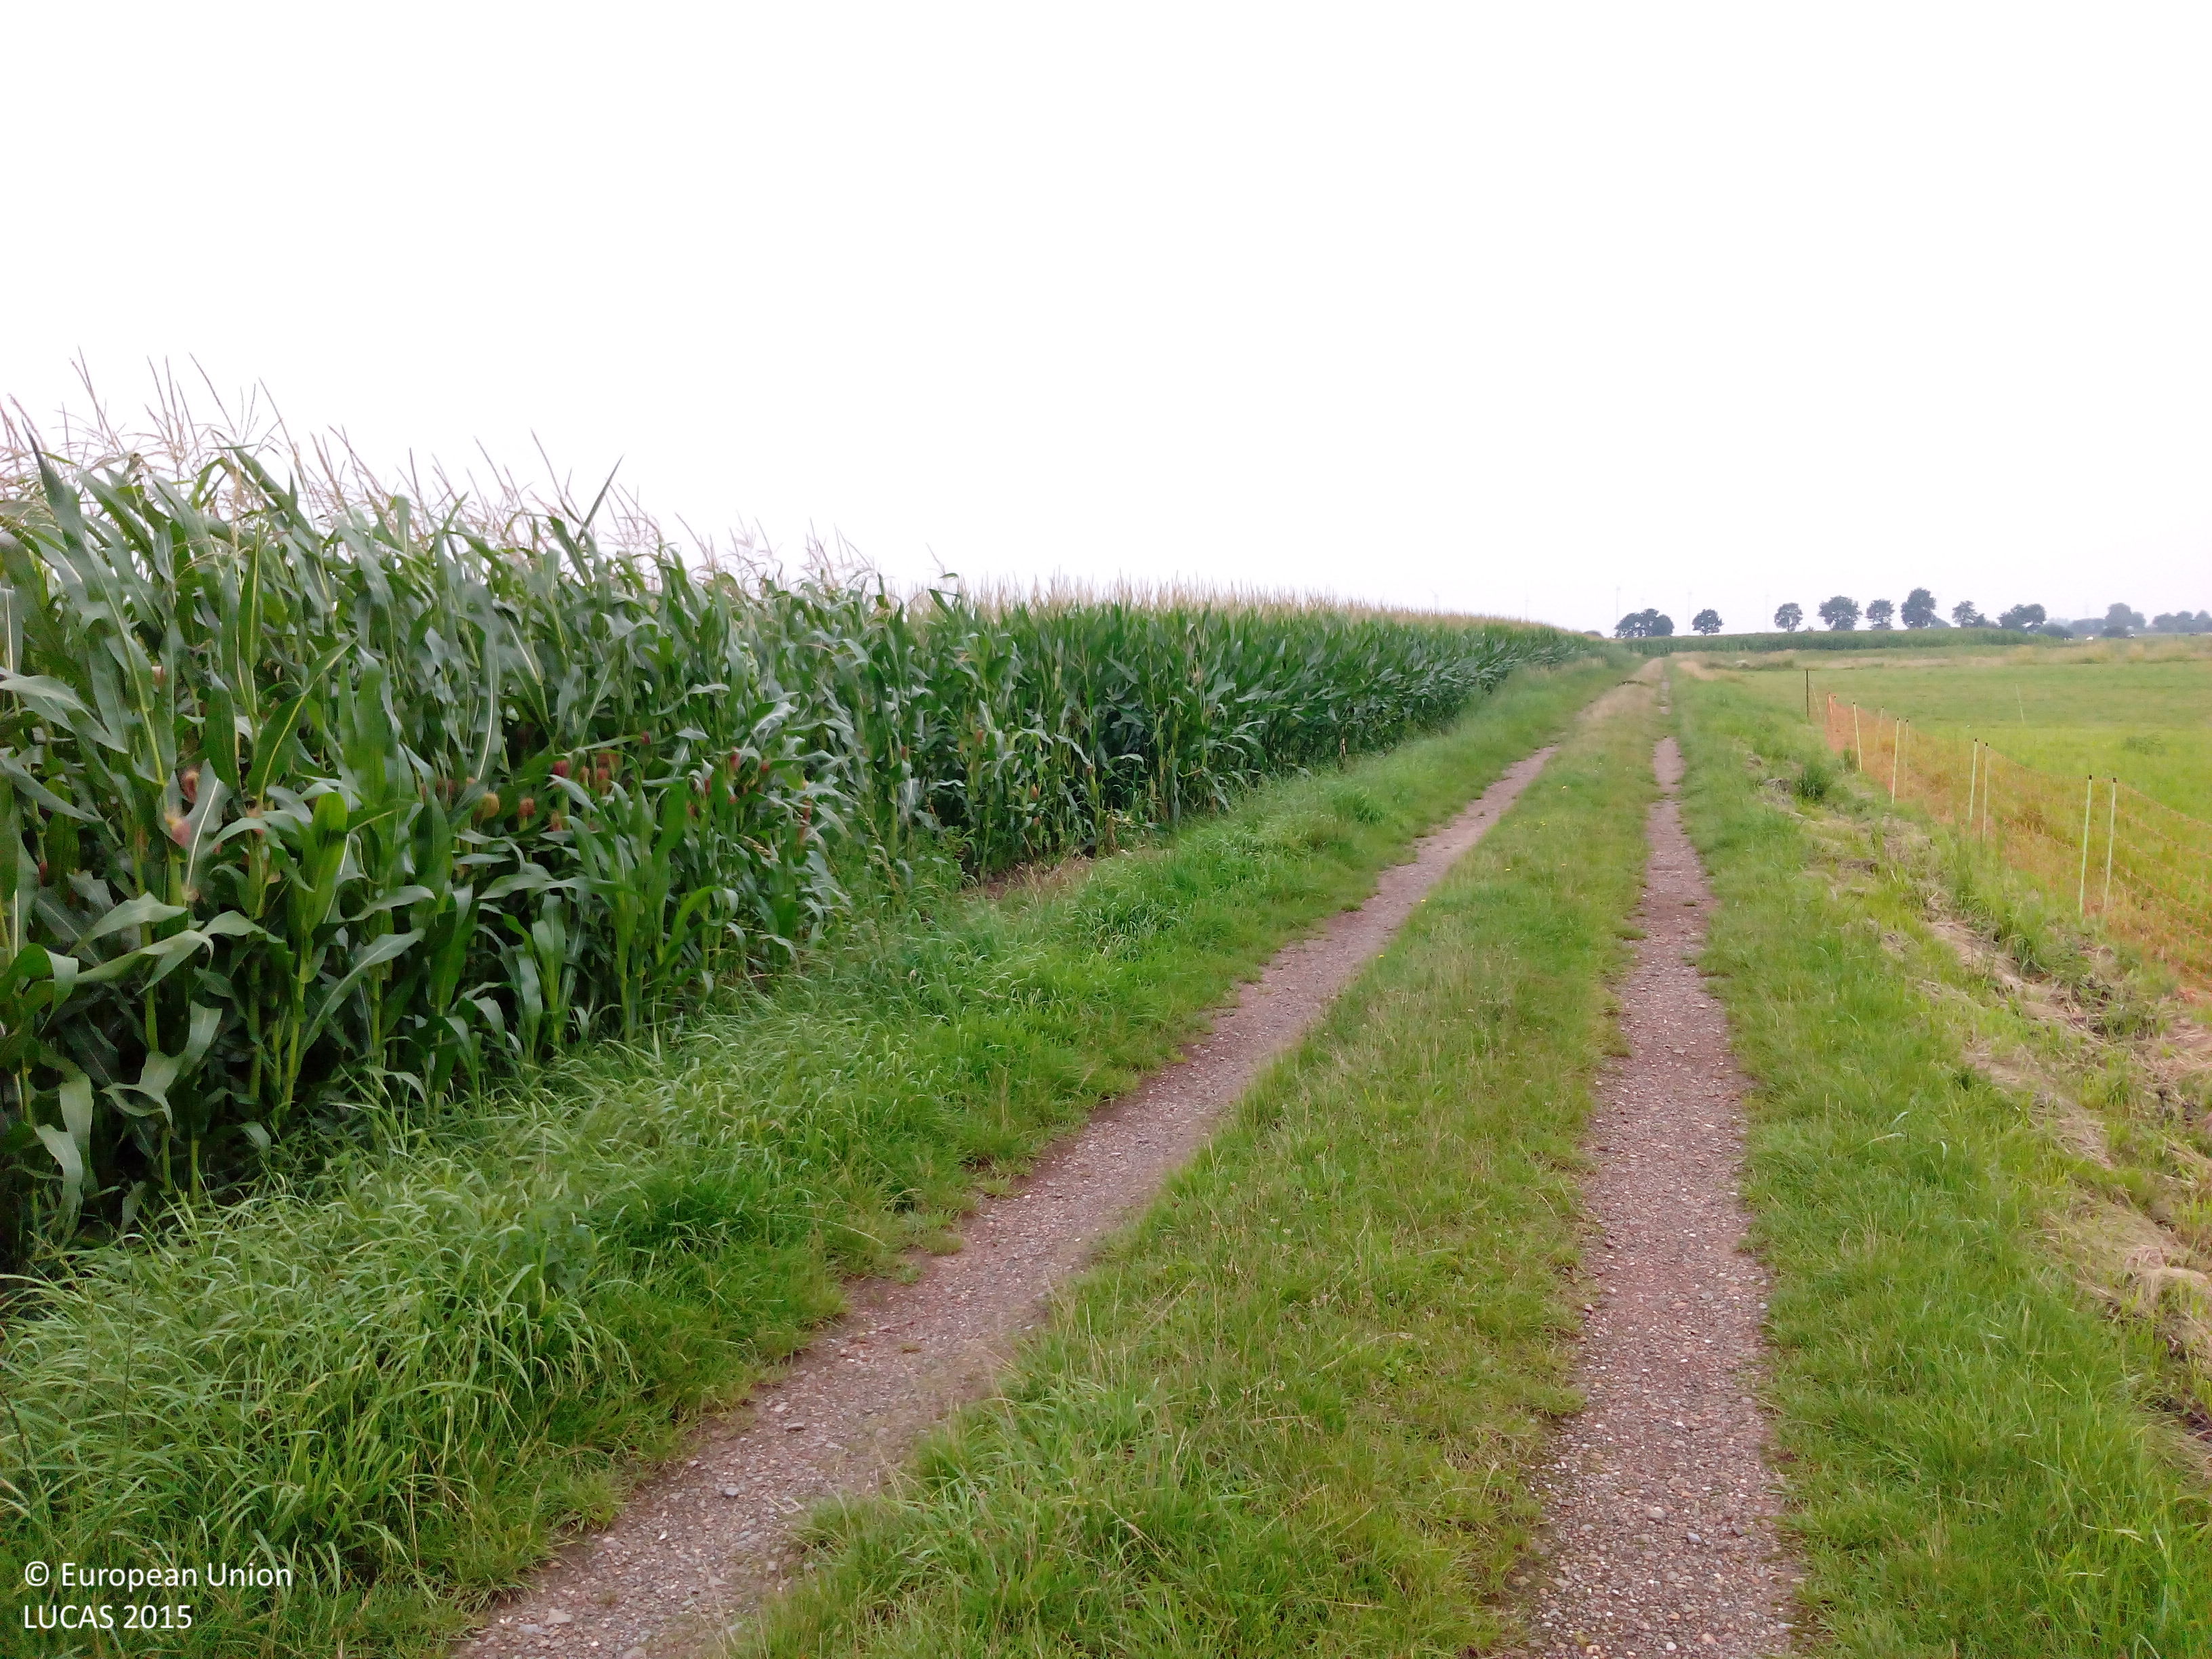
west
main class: Cropland
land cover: Maize
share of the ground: > 75 %
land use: Agriculture (excluding fallow land and kitchen gardens)
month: August
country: DE
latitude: 52.4936
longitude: 8.4834
